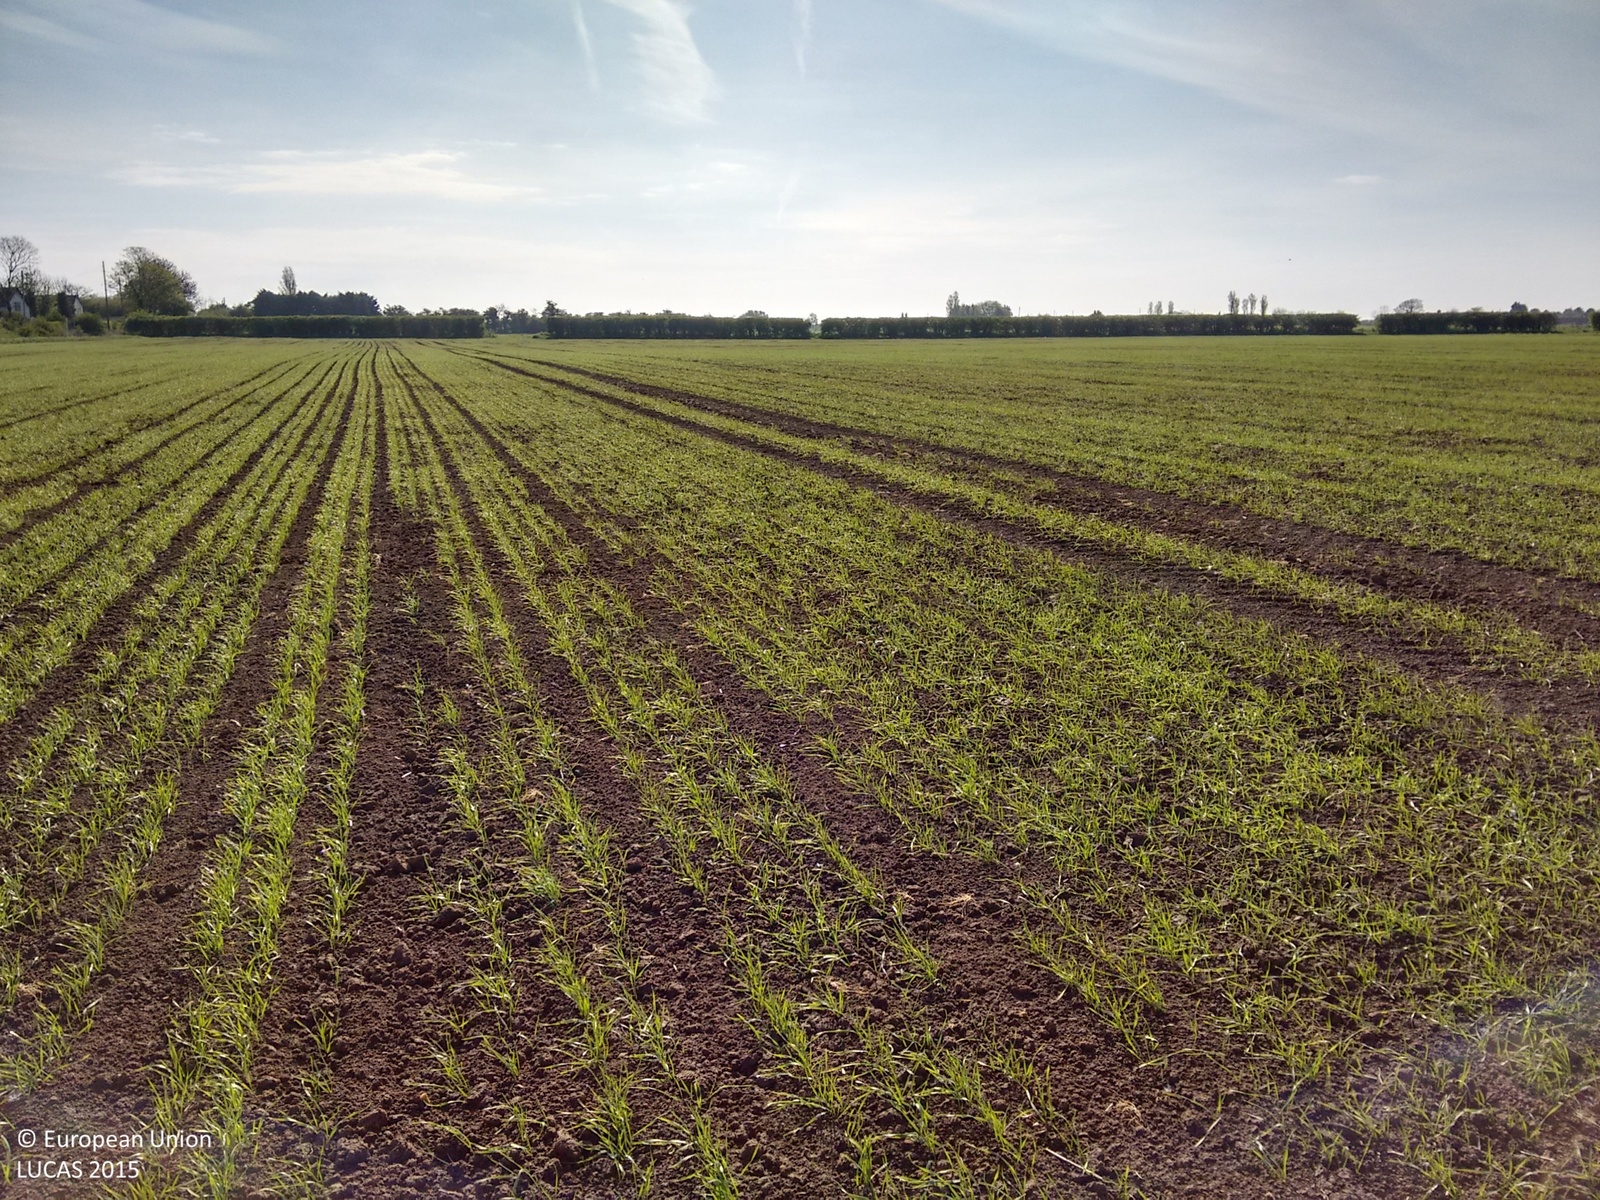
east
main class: Cropland
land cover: Common wheat
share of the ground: < 10 %
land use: Agriculture (excluding fallow land and kitchen gardens)
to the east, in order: Common wheat; Grass margins; Tracks; Grass margins; Managed hedges; Grass margins; Tracks; Grass margins; Common wheat
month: May
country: GB
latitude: 53.2807
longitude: 0.2670
